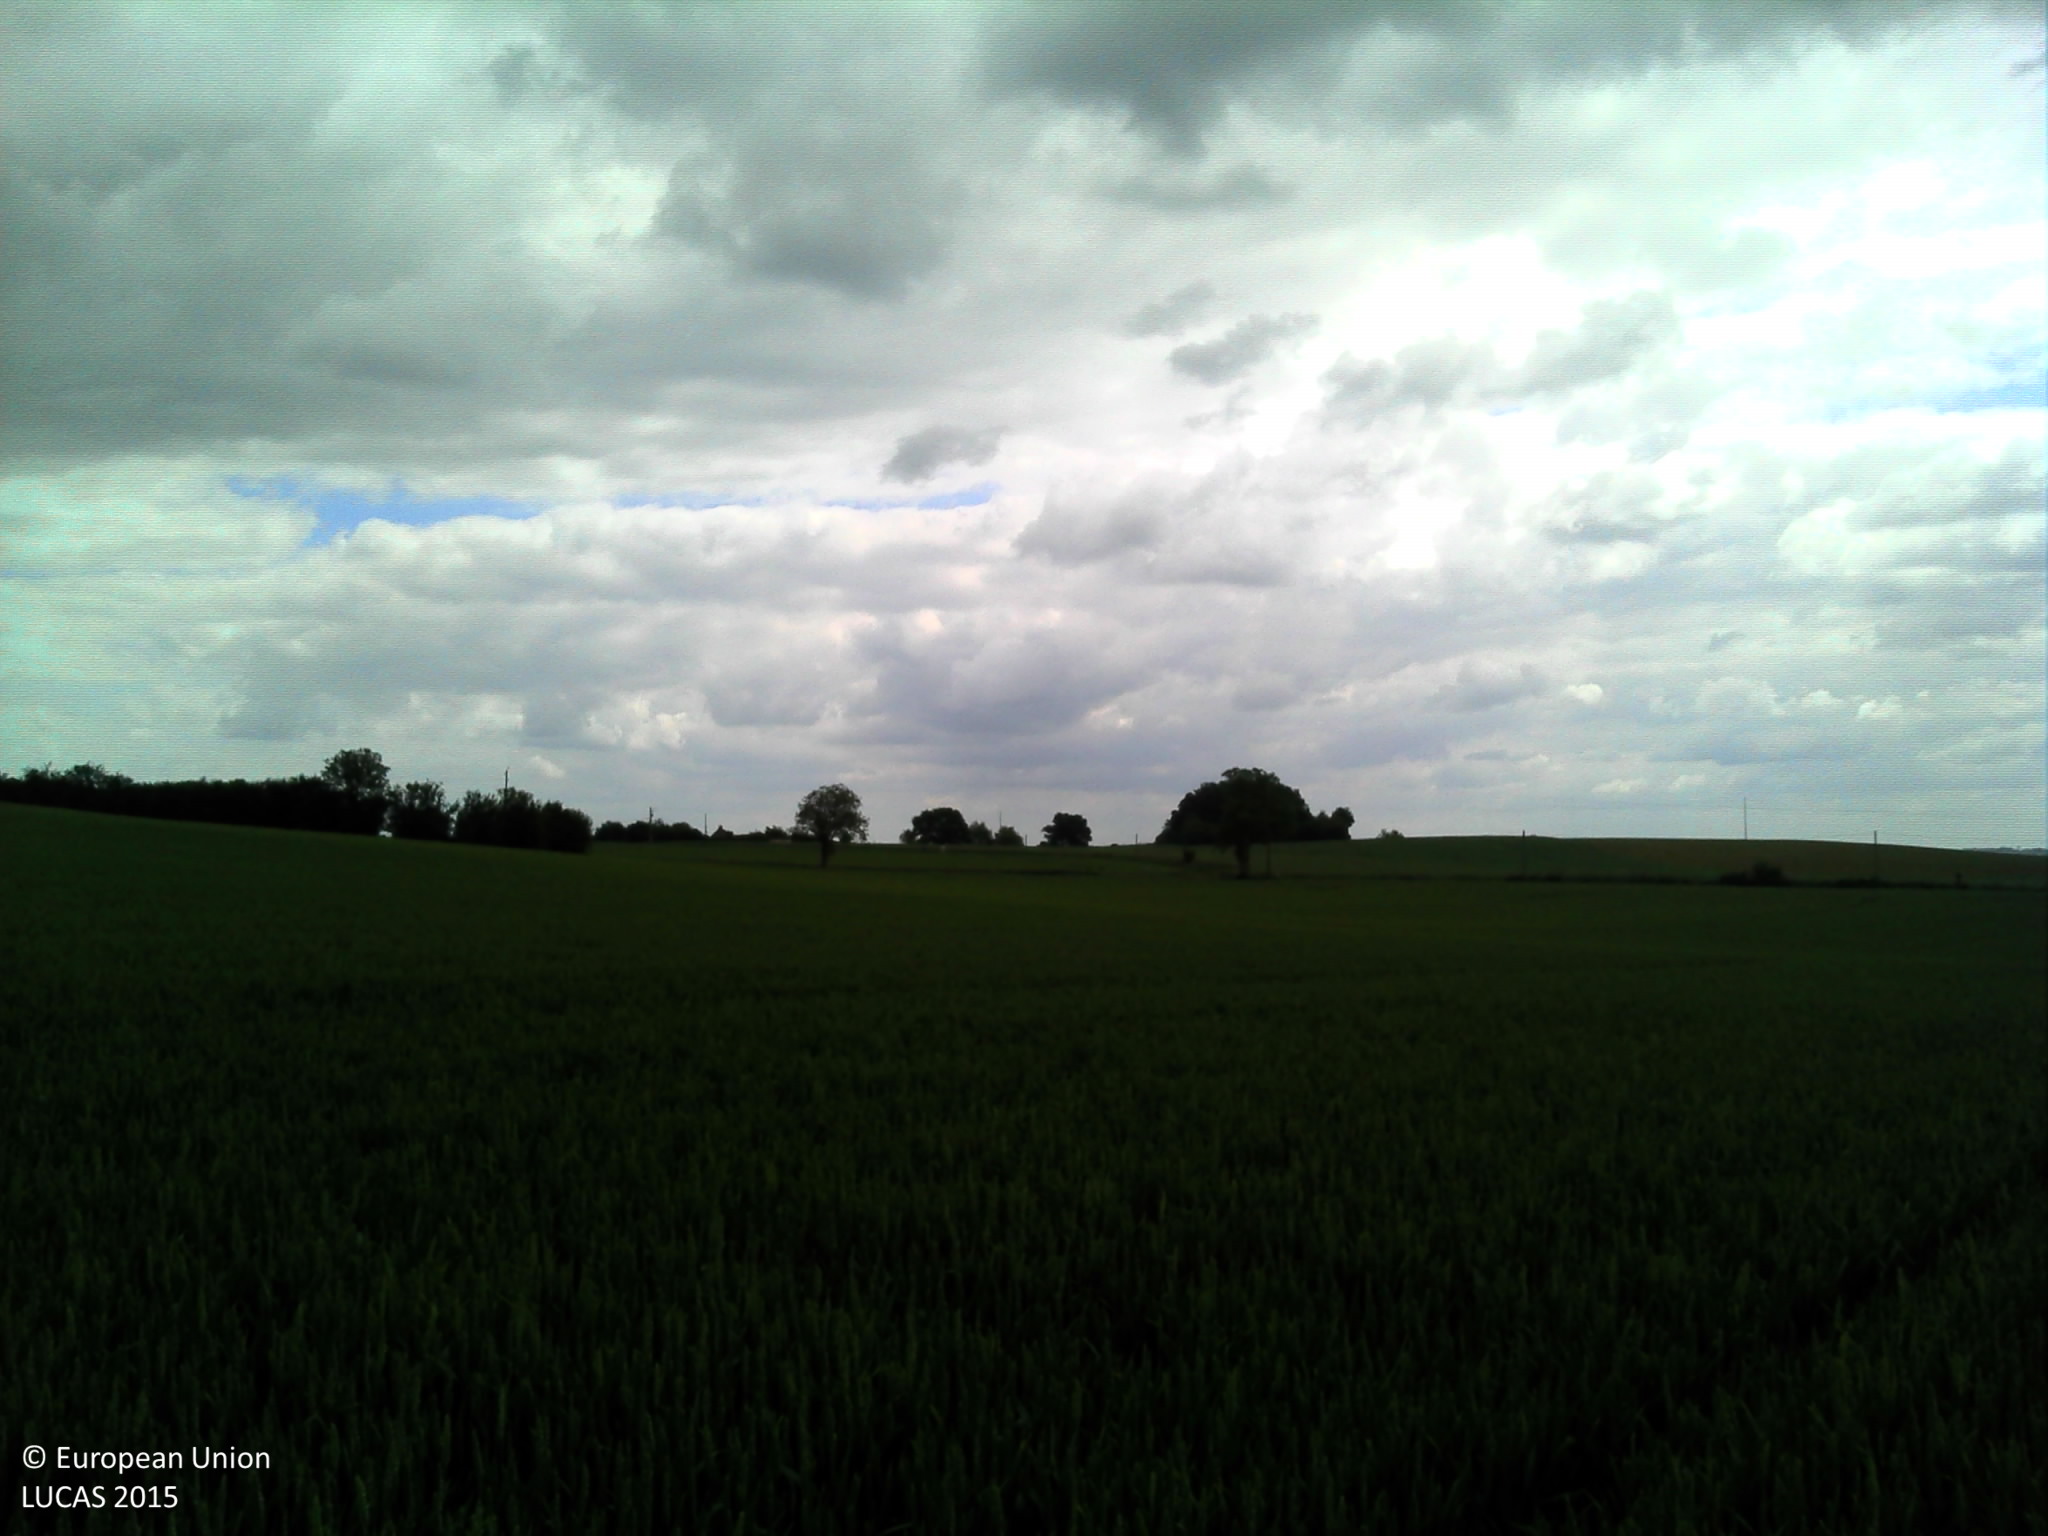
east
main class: Cropland
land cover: Common wheat
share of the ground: > 75 %
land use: Agriculture (excluding fallow land and kitchen gardens)
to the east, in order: Spontaneously vegetated surfaces; Common wheat; Electric lines; Common wheat; Single bushes/trees; Grass margins; Ditches and canals; Grass margins; Paved roads, cycling and walking lanes
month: May
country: FR
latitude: 48.0305
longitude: -0.1003
